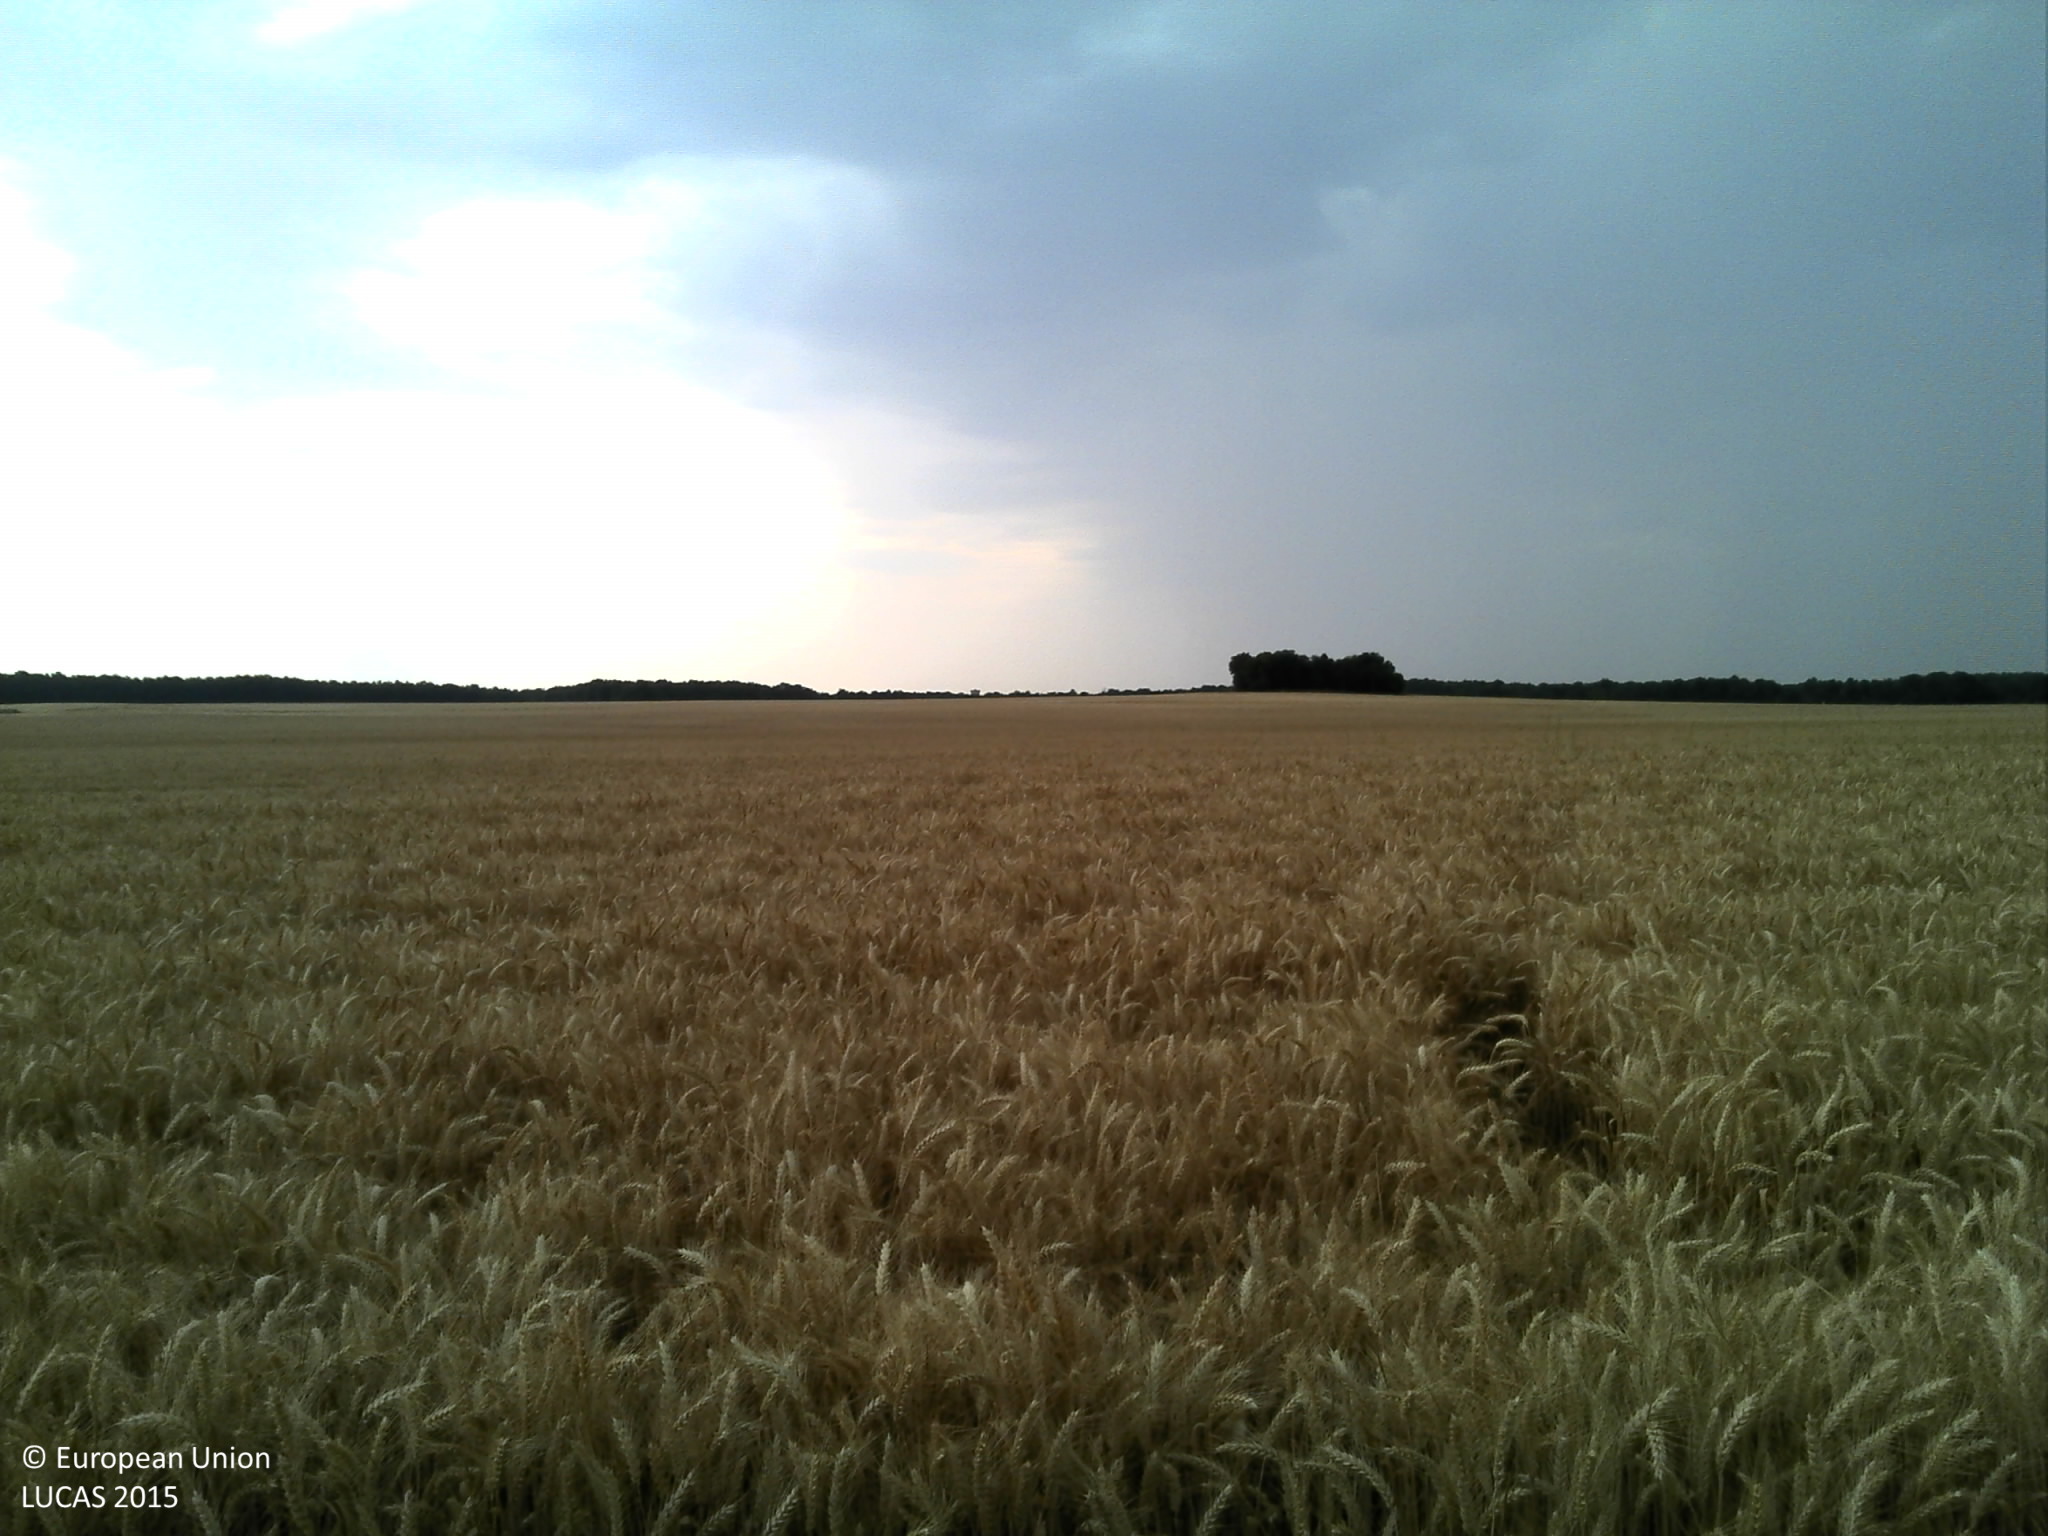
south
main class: Cropland
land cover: Durum wheat
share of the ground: > 75 %
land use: Agriculture (excluding fallow land and kitchen gardens)
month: July
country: FR
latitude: 48.3259
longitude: 2.4499
